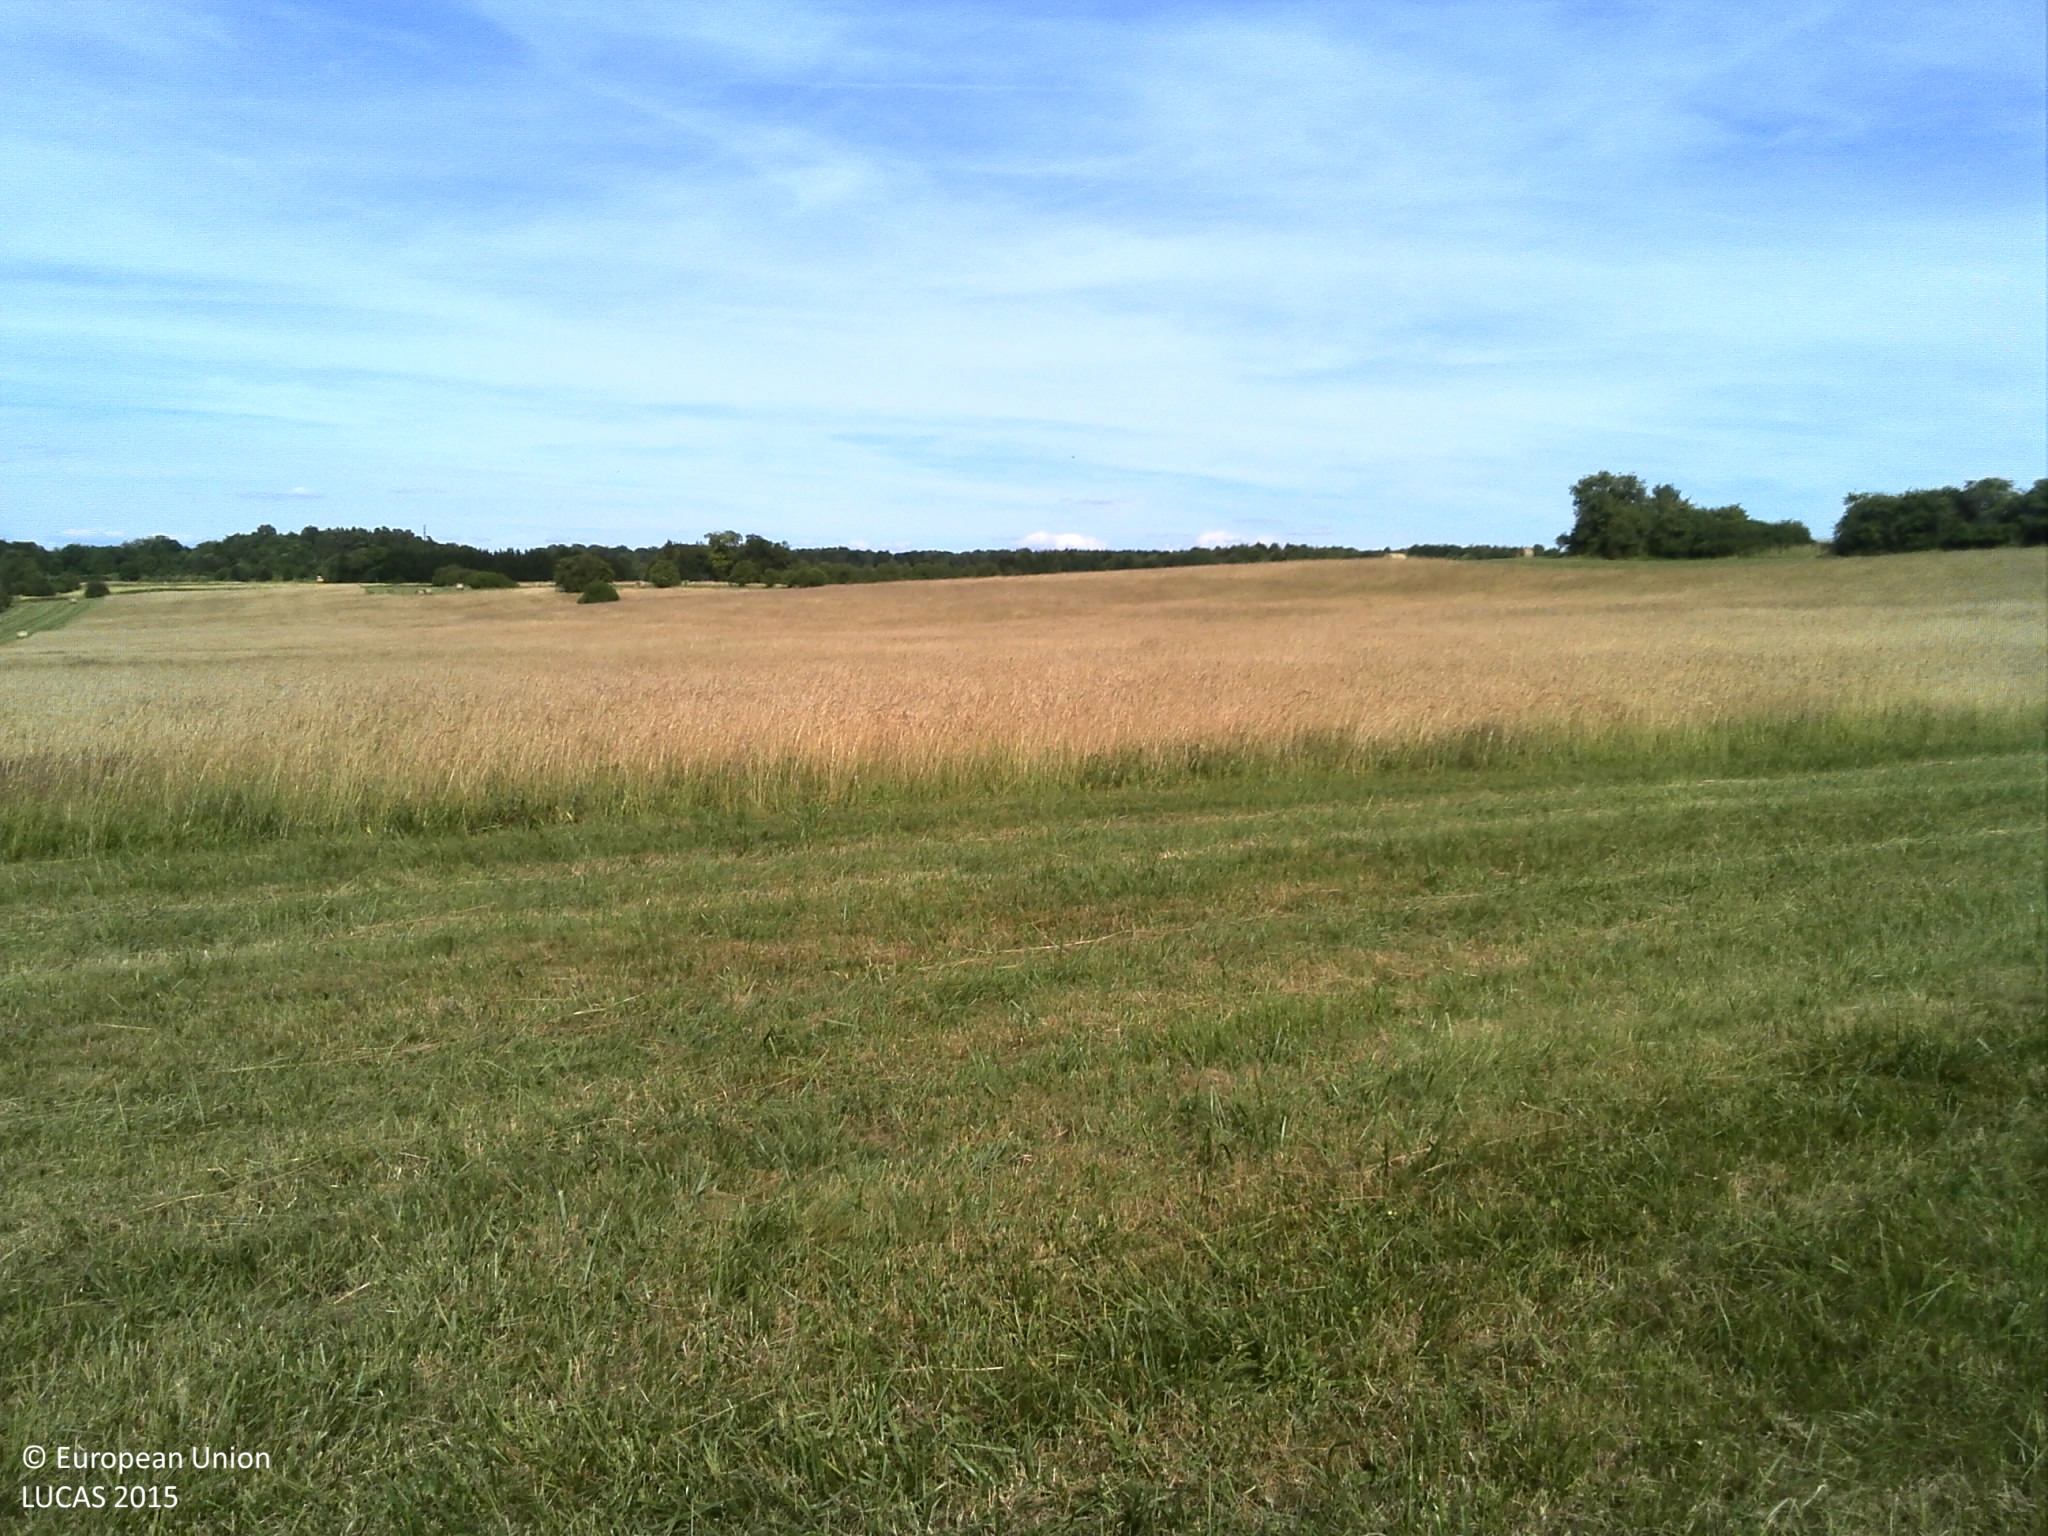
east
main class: Grassland
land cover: Grassland without tree/shrub cover
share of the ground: > 75 %
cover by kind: herbaceous plants 100 %
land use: Agriculture (excluding fallow land and kitchen gardens)
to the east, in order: Grassland without tree/shrub cover
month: June
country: FR
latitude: 49.3387
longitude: 5.9669
